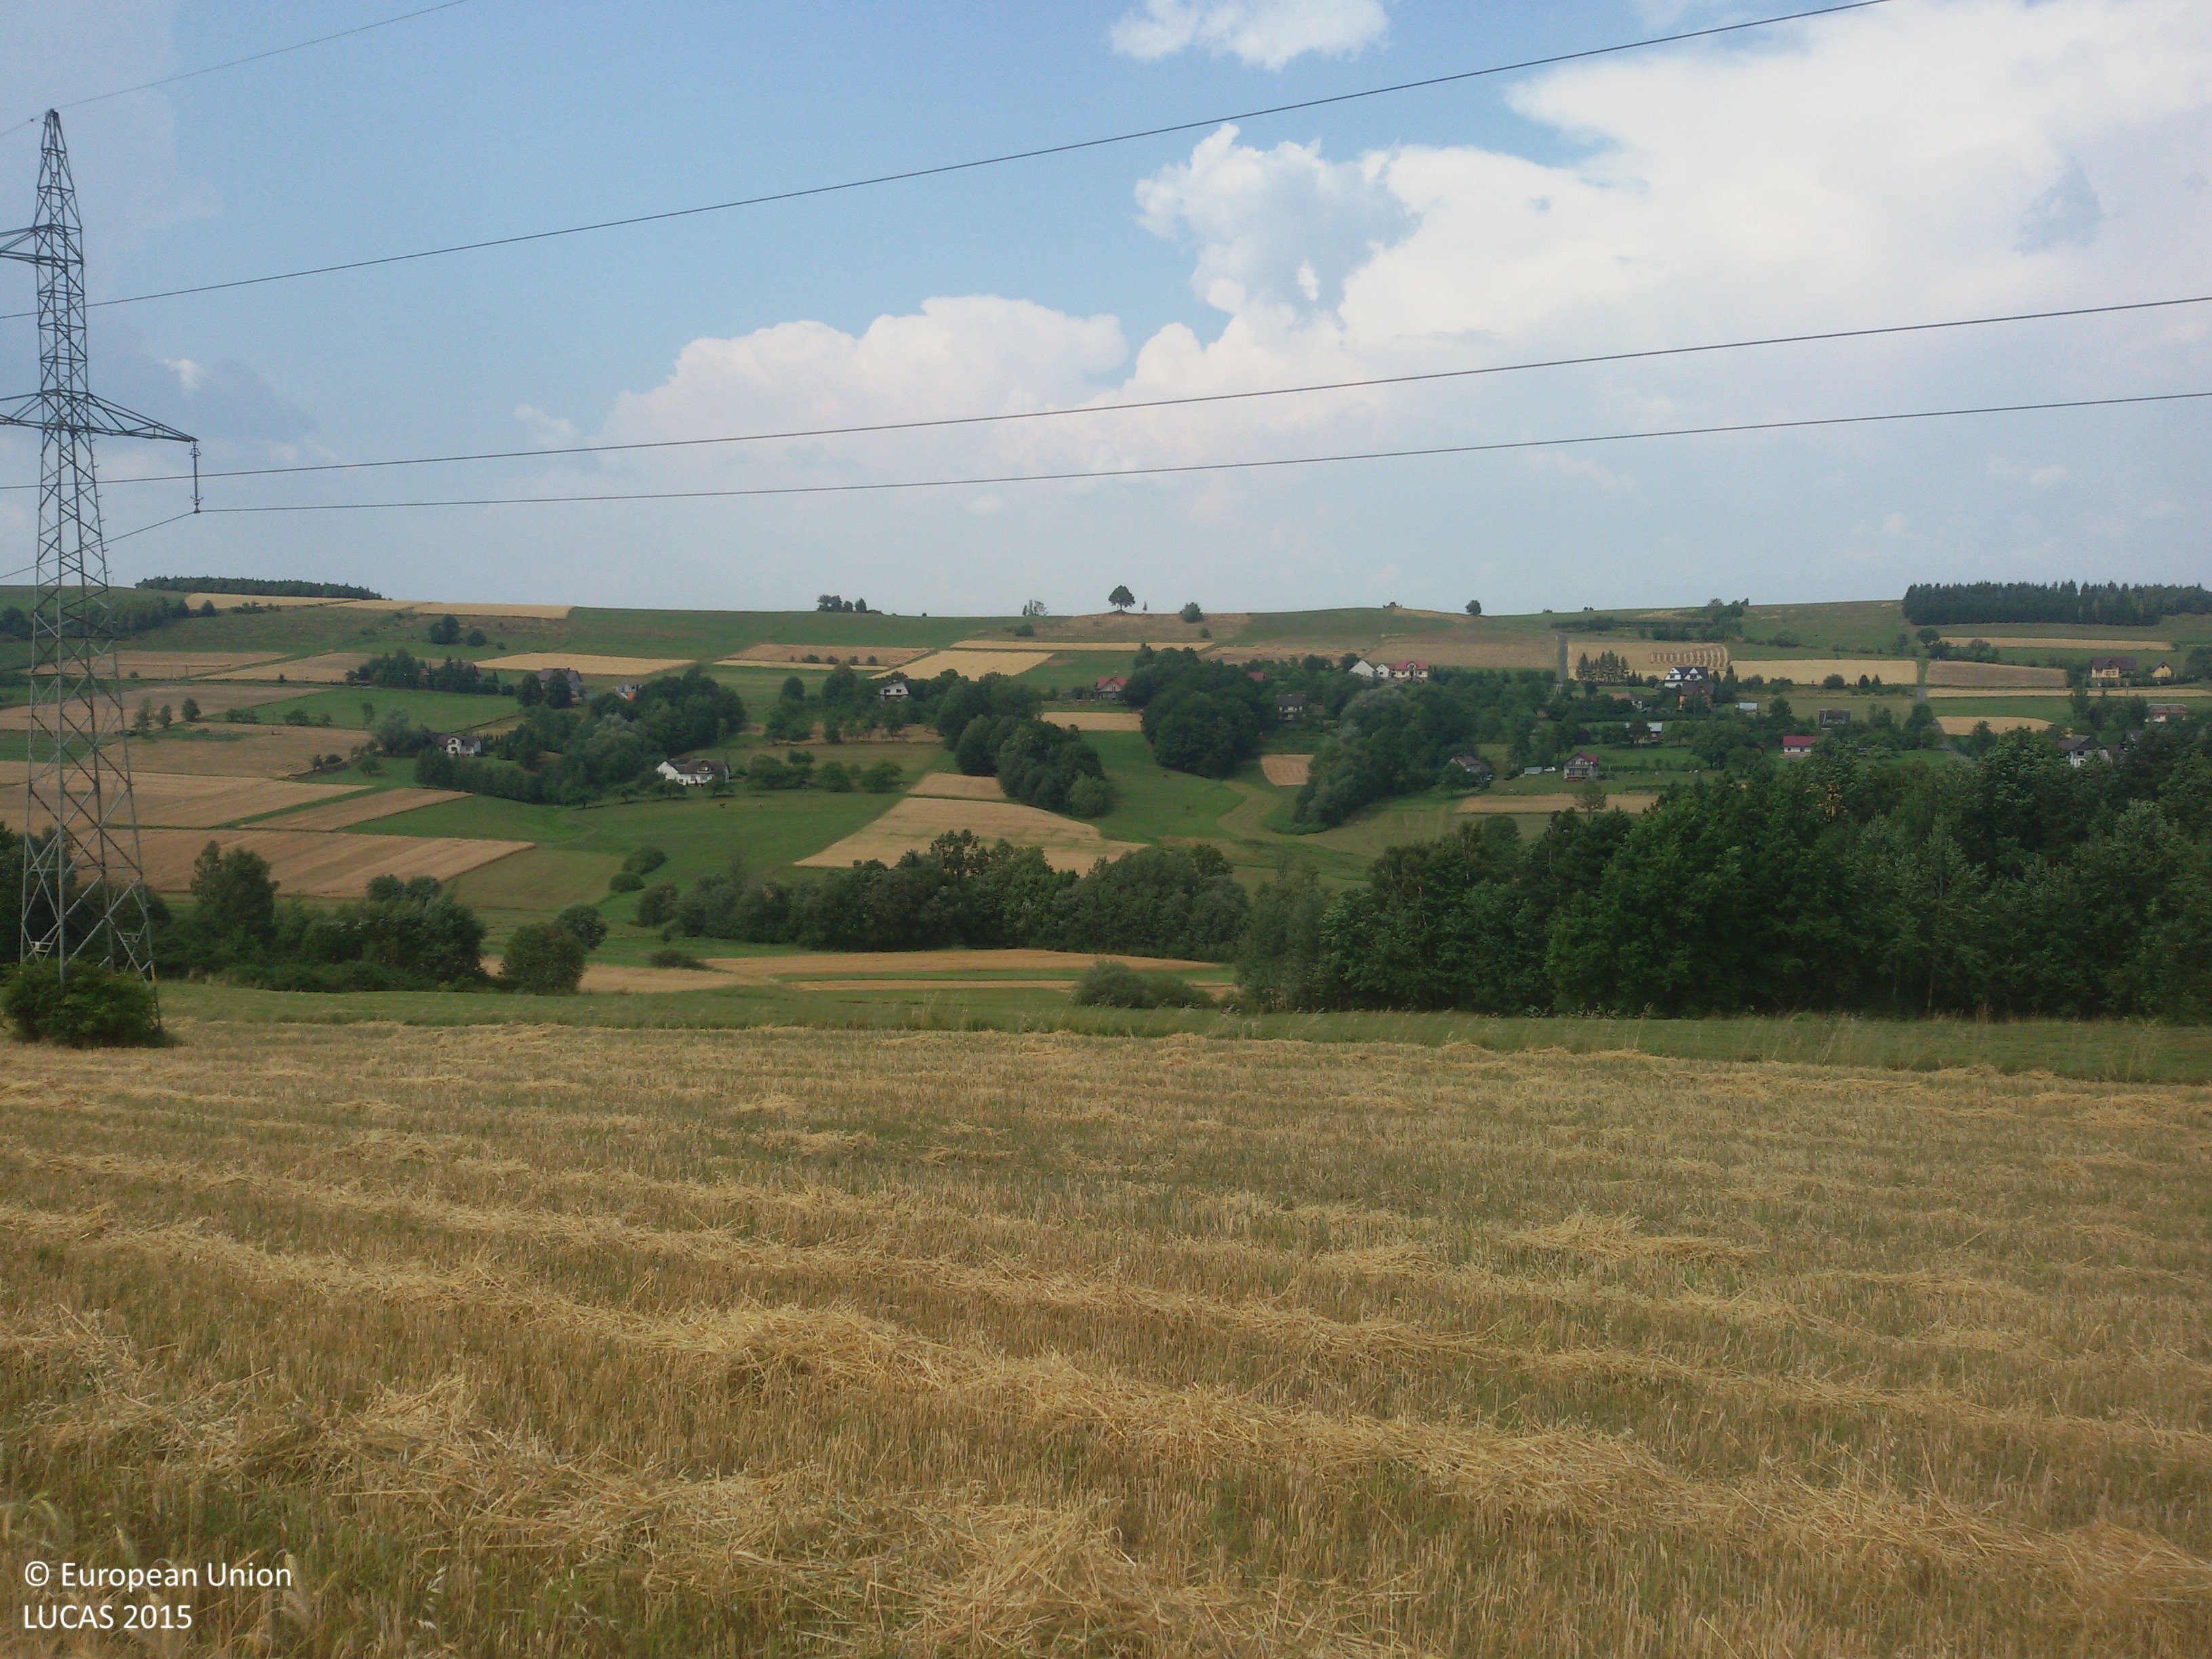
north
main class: Cropland
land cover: Mixed cereals for fodder
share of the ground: > 75 %
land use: Agriculture (excluding fallow land and kitchen gardens)
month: August
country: PL
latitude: 49.7382
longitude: 20.2610
